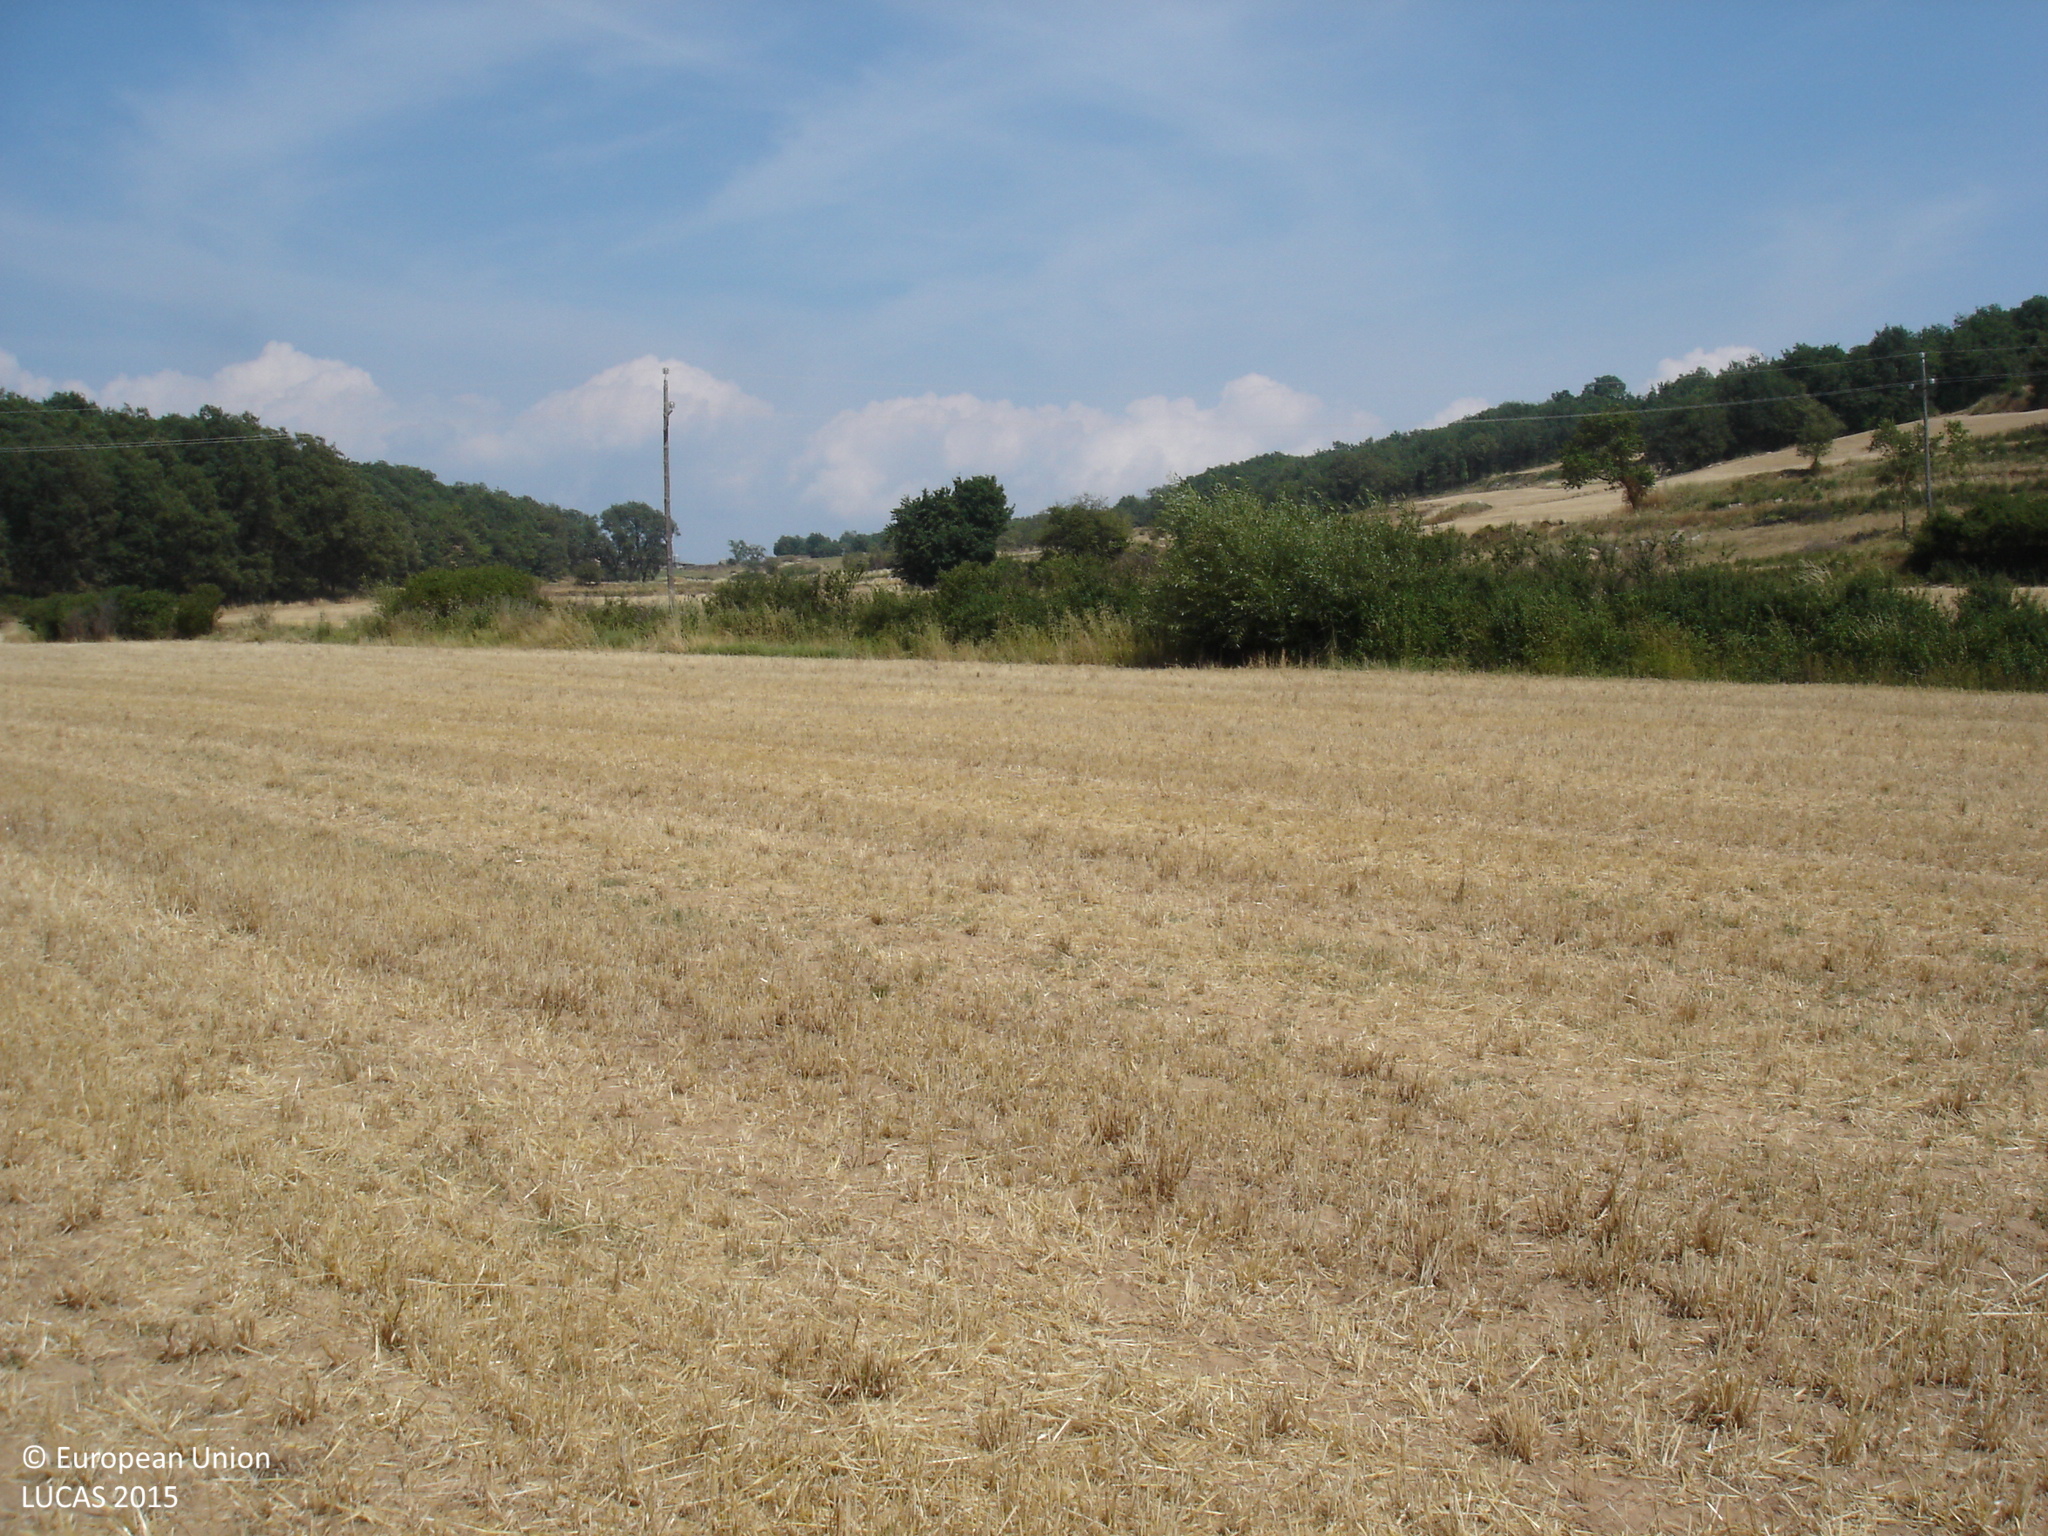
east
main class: Cropland
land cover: Barley
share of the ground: < 10 %
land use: Agriculture (excluding fallow land and kitchen gardens)
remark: Harvested field
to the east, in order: Barley; Grass margins; Rivers and streams; Shruby margins; Barley; Electric lines; Barley; Grass margins; Barley
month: July
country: ES
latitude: 41.8251
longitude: 2.1774
